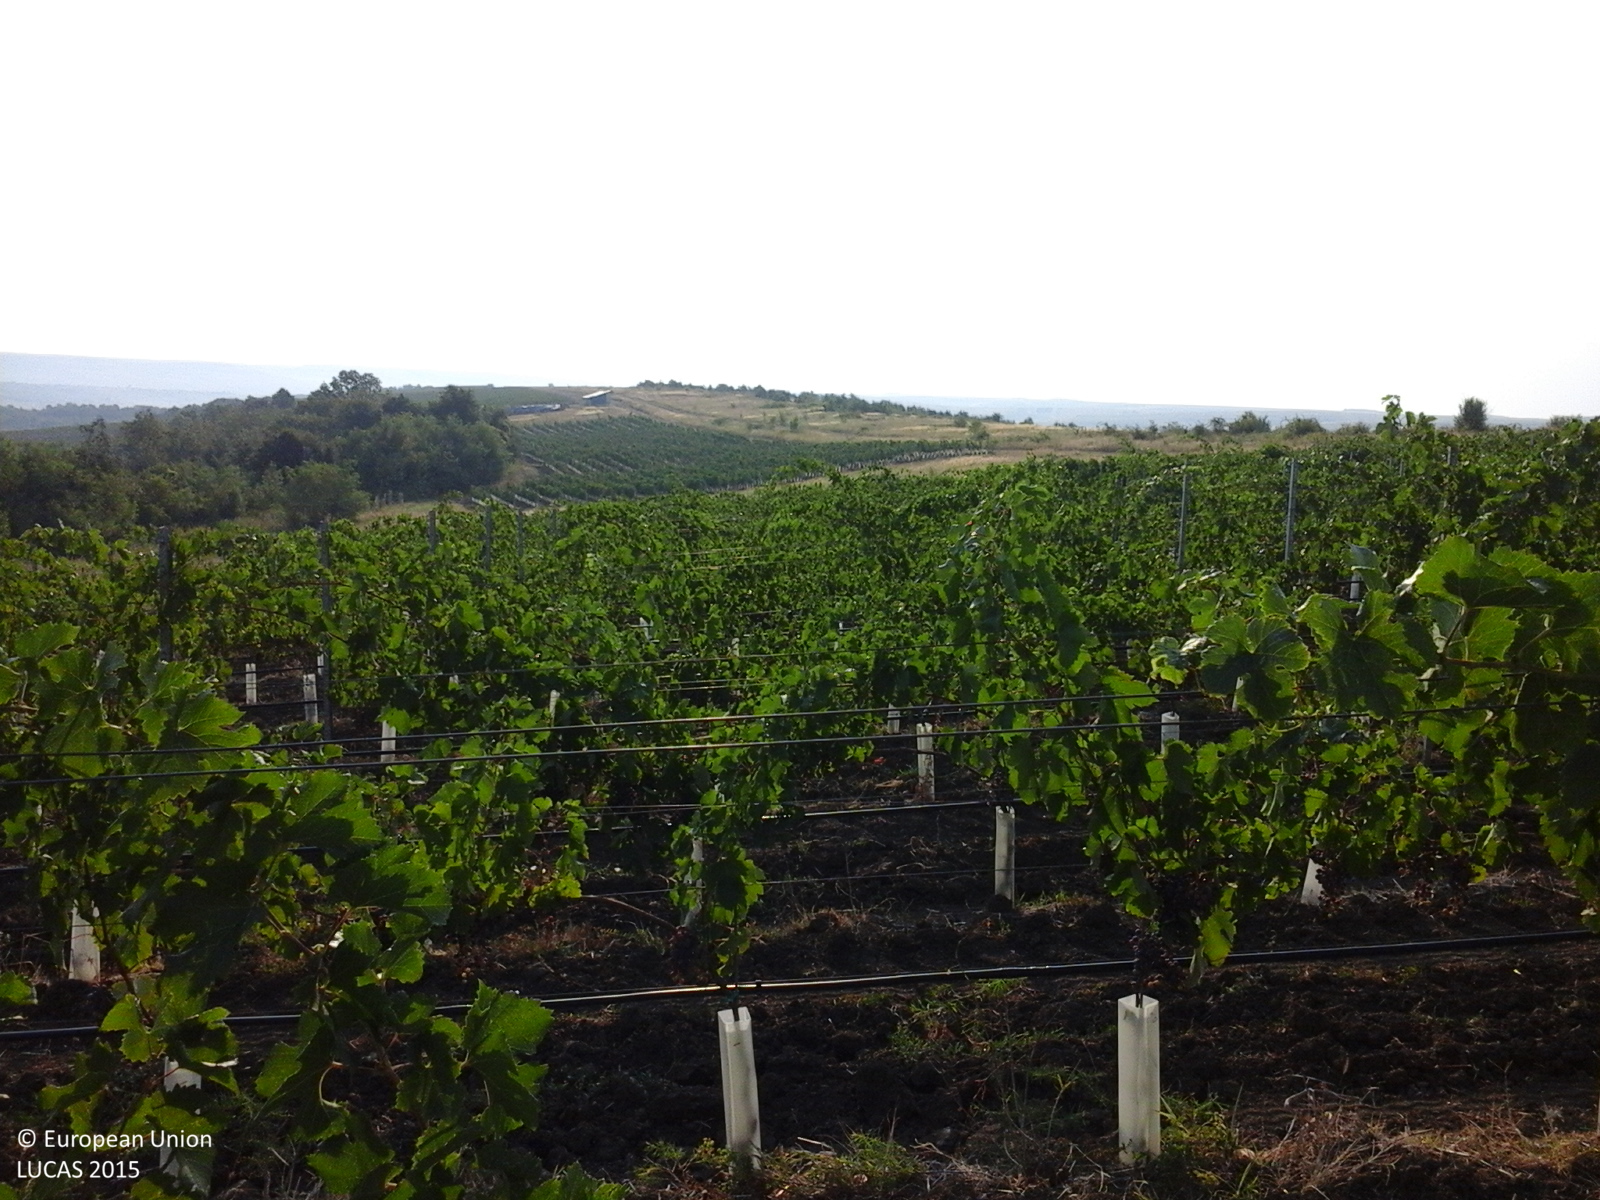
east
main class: Cropland
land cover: Vineyards
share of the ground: 25 - 50 %
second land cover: Other bare soil
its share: > 75 %
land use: Agriculture (excluding fallow land and kitchen gardens)
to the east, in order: Vineyards; Other bare soil; Grassland without tree/shrub cover; Vineyards
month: August
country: RO
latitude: 44.4921
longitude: 23.3172
